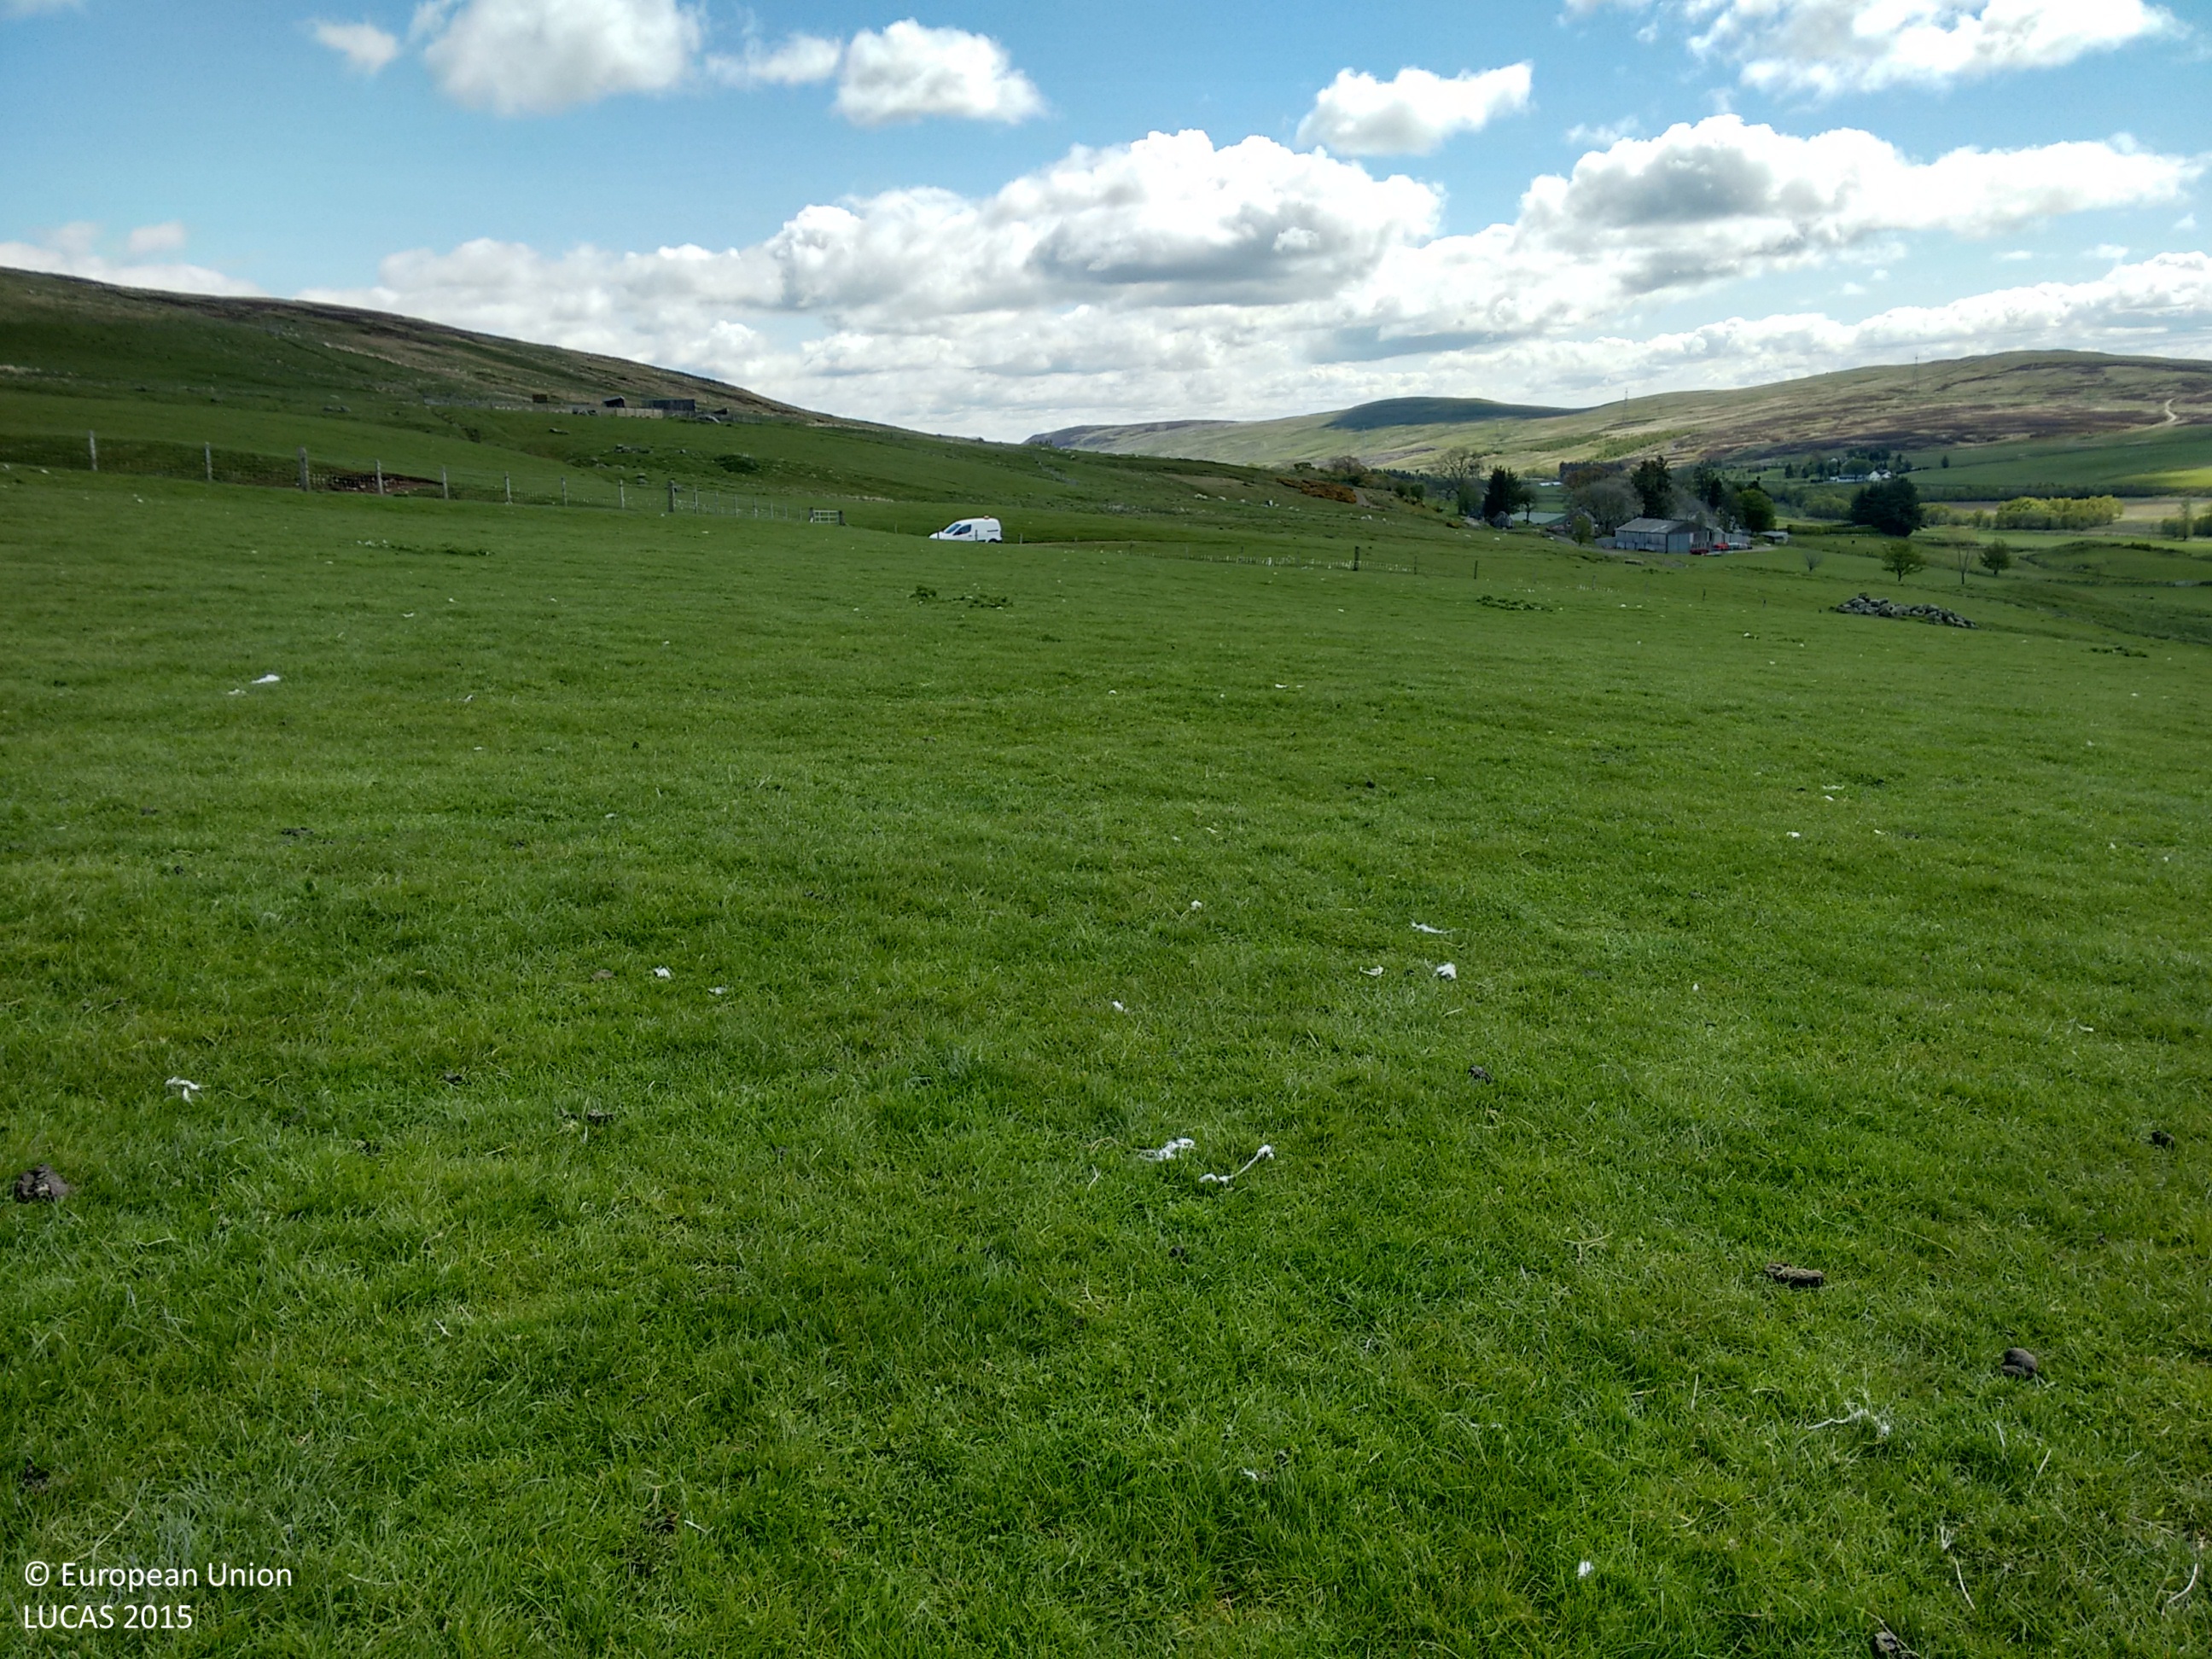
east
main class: Grassland
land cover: Grassland without tree/shrub cover
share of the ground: > 75 %
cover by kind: herbaceous plants 100 %
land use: Agriculture (excluding fallow land and kitchen gardens)
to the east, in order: Grassland without tree/shrub cover; Fences; Grassland without tree/shrub cover; Rivers and streams; Grassland without tree/shrub cover; Tracks; Grassland without tree/shrub cover; Rivers and streams; Grassland without tree/shrub cover; Rivers and streams; Grassland without tree/shrub cover
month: June
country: GB
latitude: 56.4226
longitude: -3.8134
